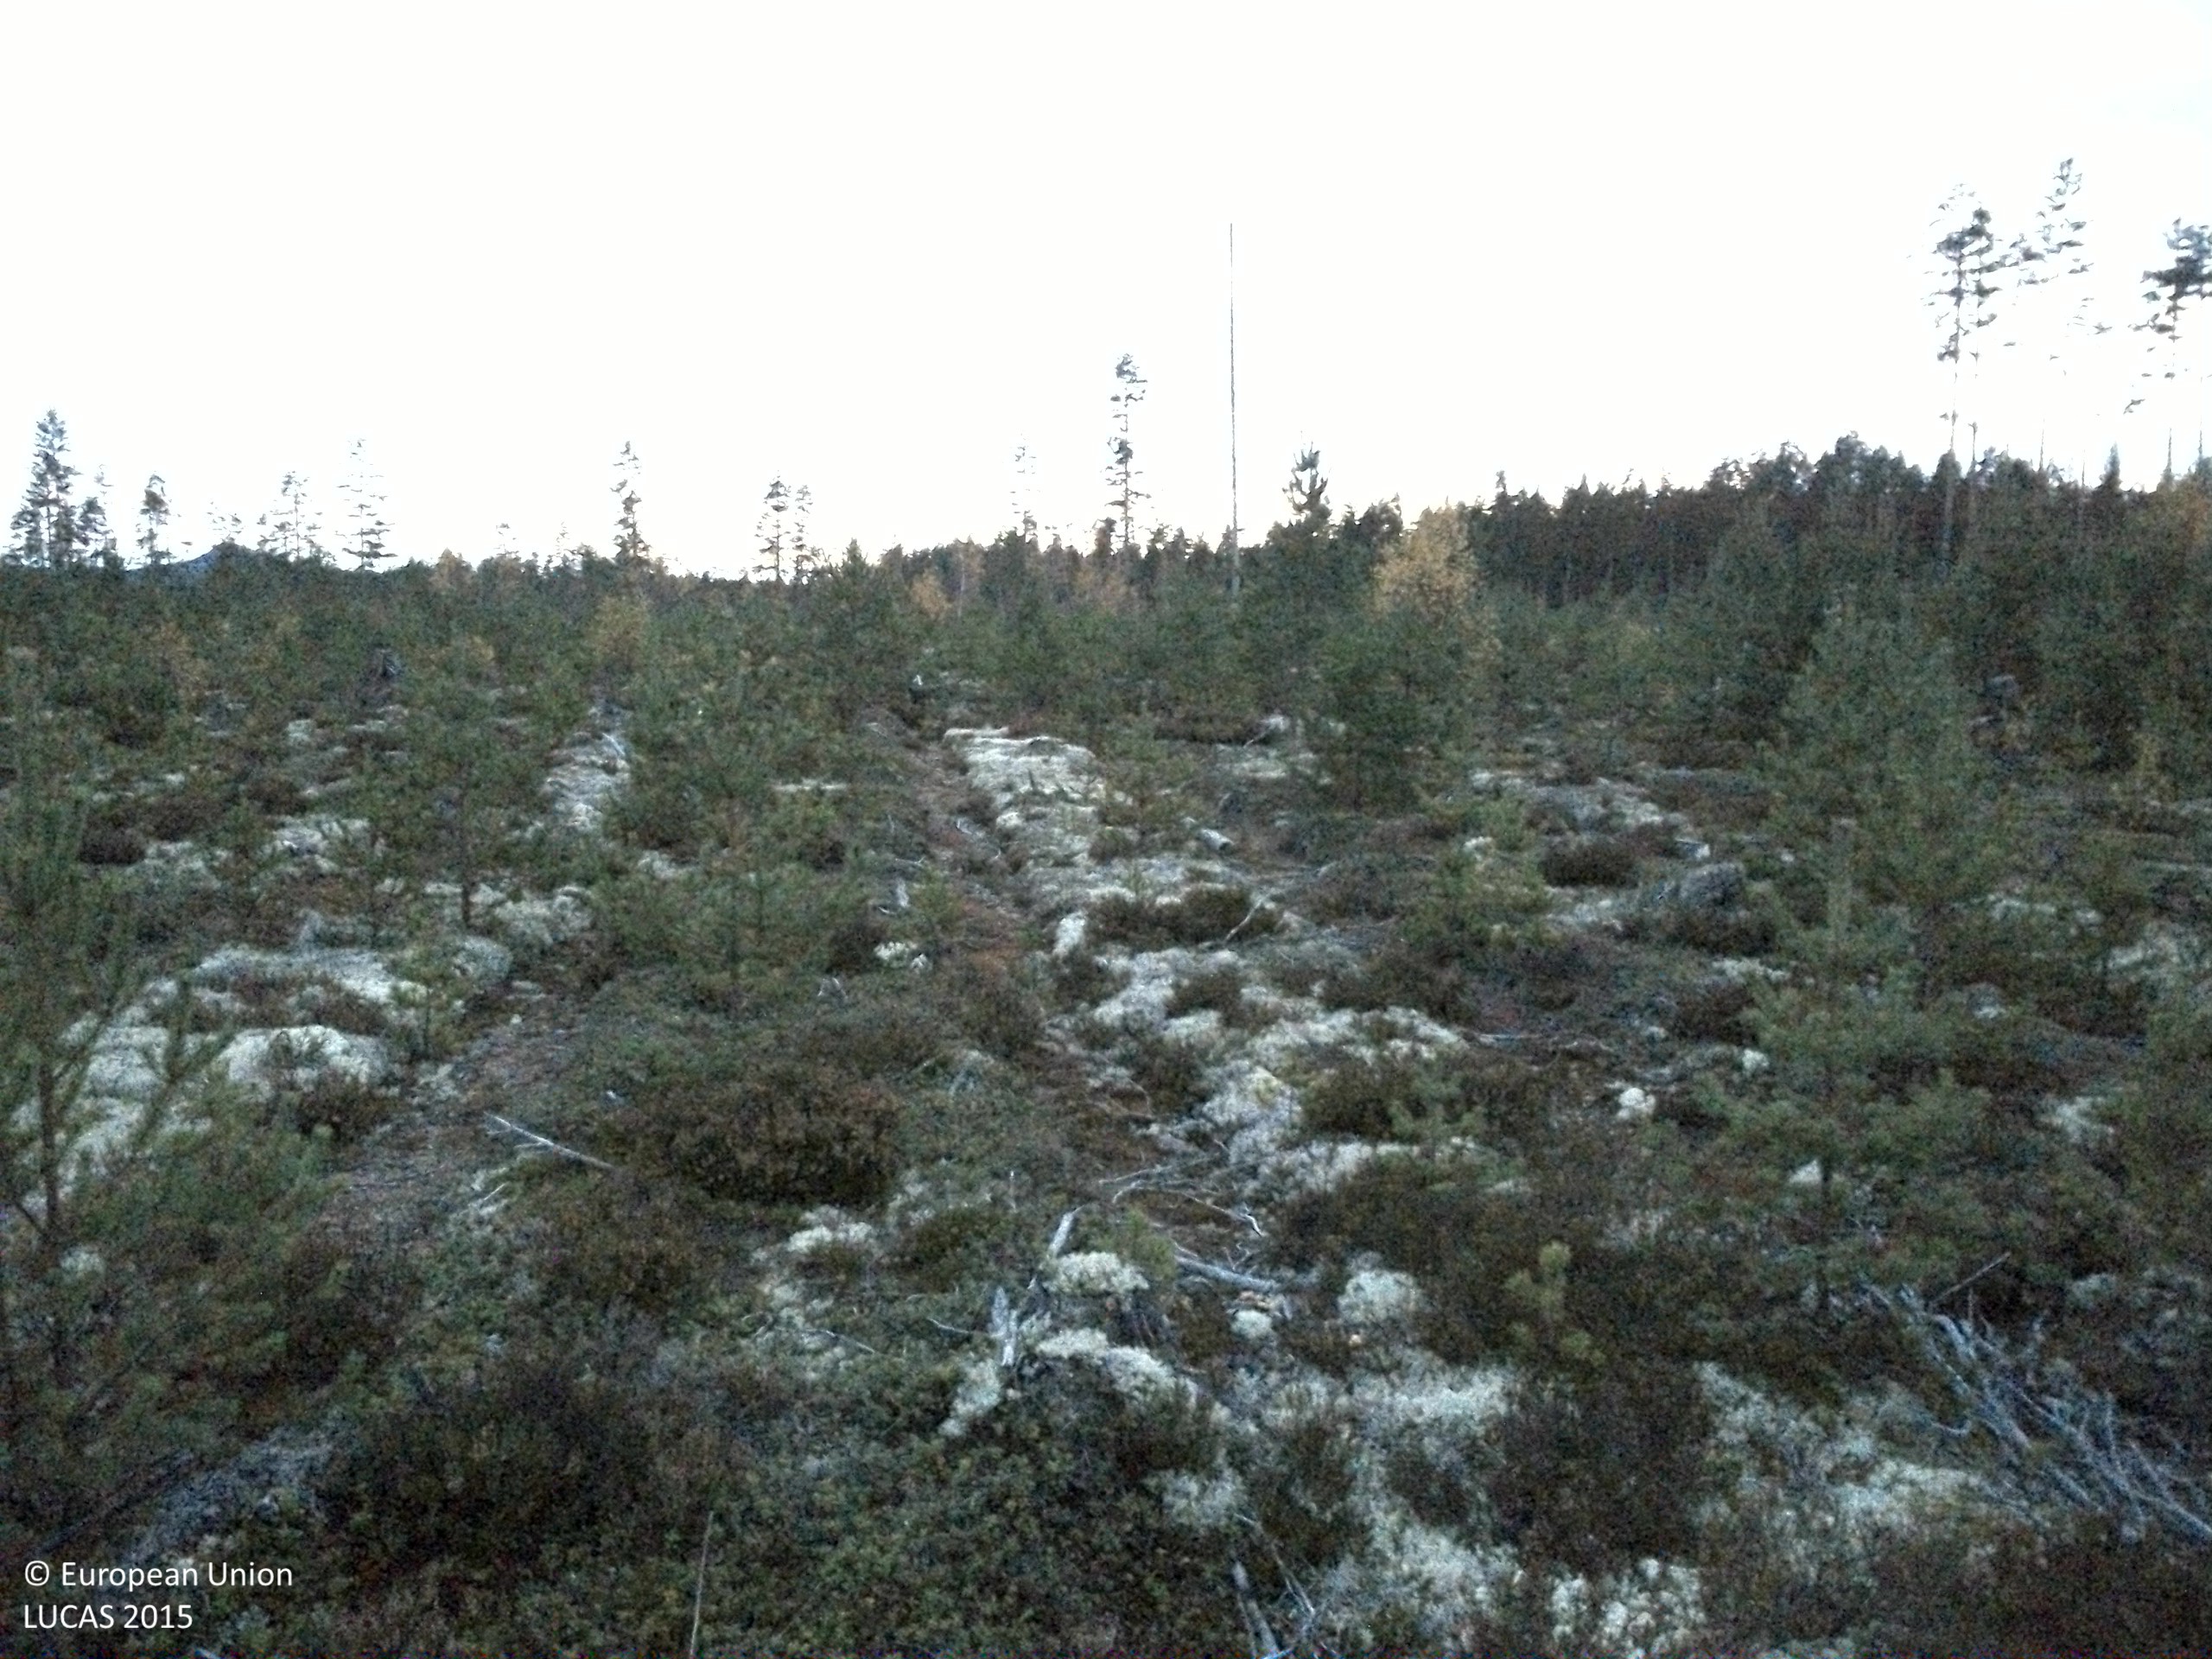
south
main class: Woodland
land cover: Pine dominated coniferous woodland
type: boreal forest
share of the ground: 25 - 50 %
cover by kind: shrubs 40 %, coniferous forest trees 35 %, lichens and mosses 10 %, consolidated bare surface 10 %, broadleaved forest trees 5 %
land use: Forestry
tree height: < 5 m
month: October
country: SE
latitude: 61.3343
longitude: 15.0866
